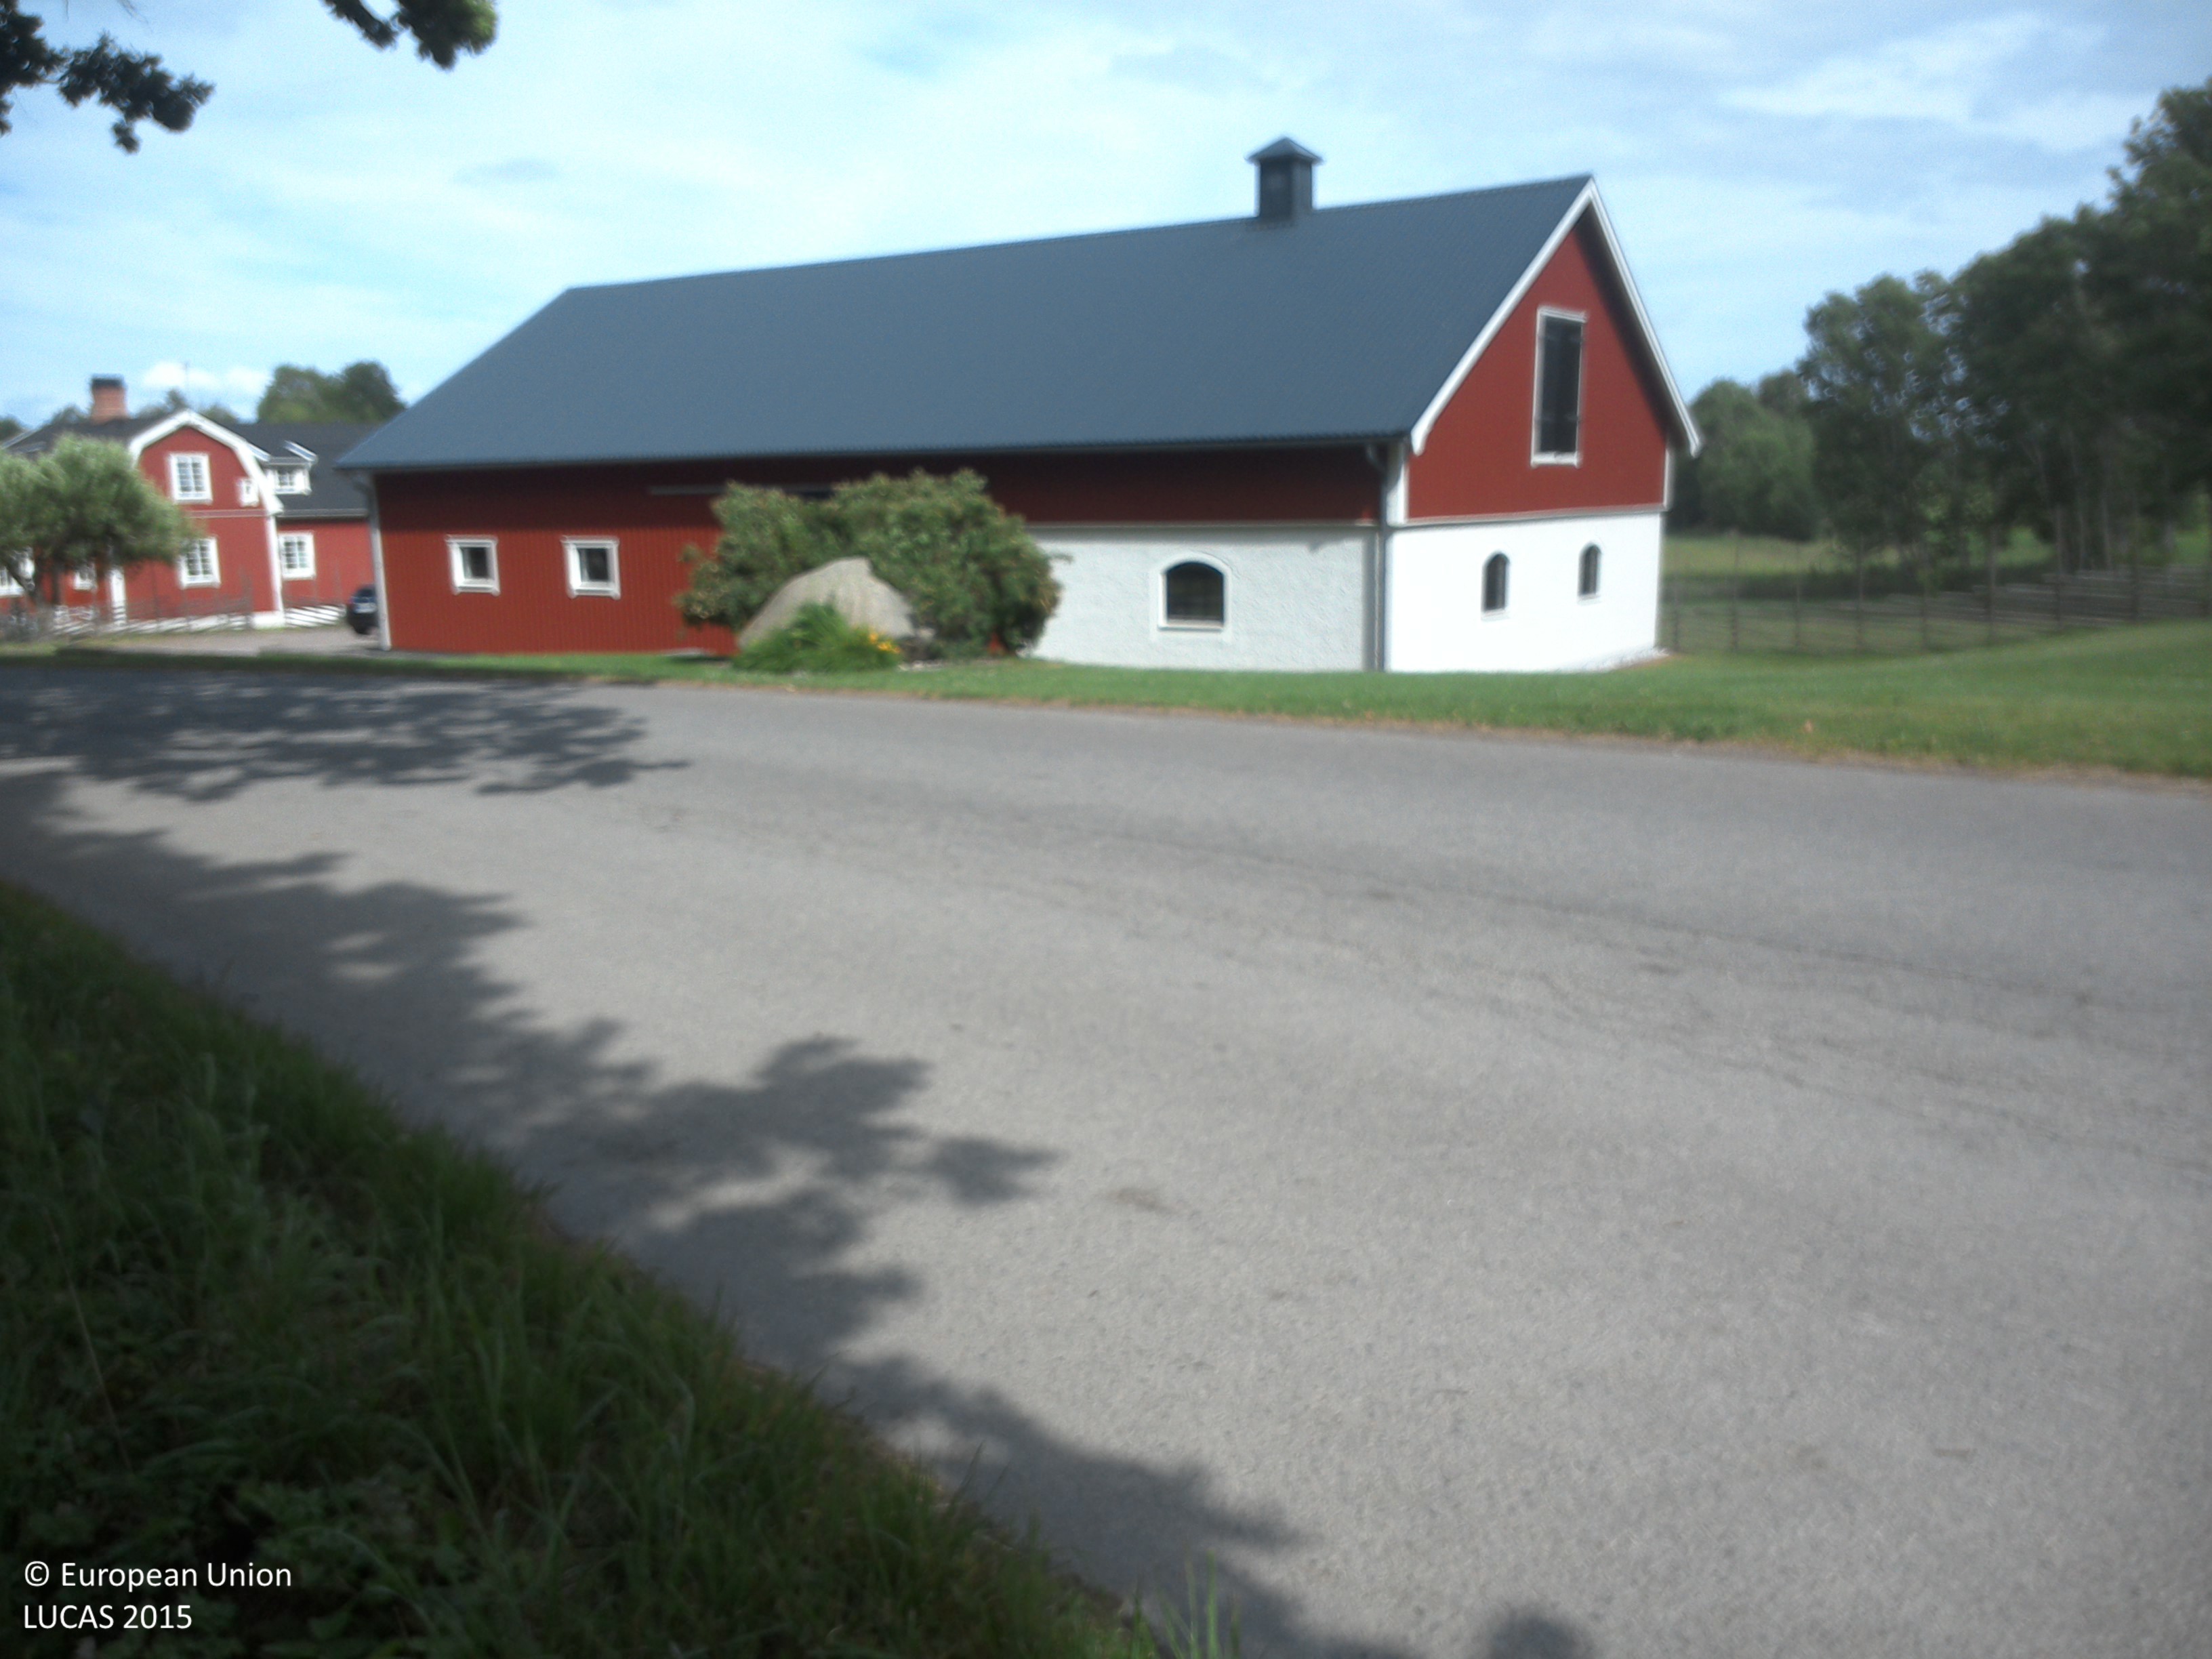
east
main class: Woodland
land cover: Broadleaved woodland
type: boreal forest
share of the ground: > 75 %
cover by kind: broadleaved forest trees 85 %, herbaceous plants 15 %
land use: Forestry
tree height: > 5 m
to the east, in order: Broadleaved woodland; Paved roads, cycling and walking lanes; Grassland without tree/shrub cover; Artificial constructions in urban areas; Grass margins; Fences; Grassland without tree/shrub cover; Broadleaved woodland
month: July
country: SE
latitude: 58.5376
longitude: 15.0954
